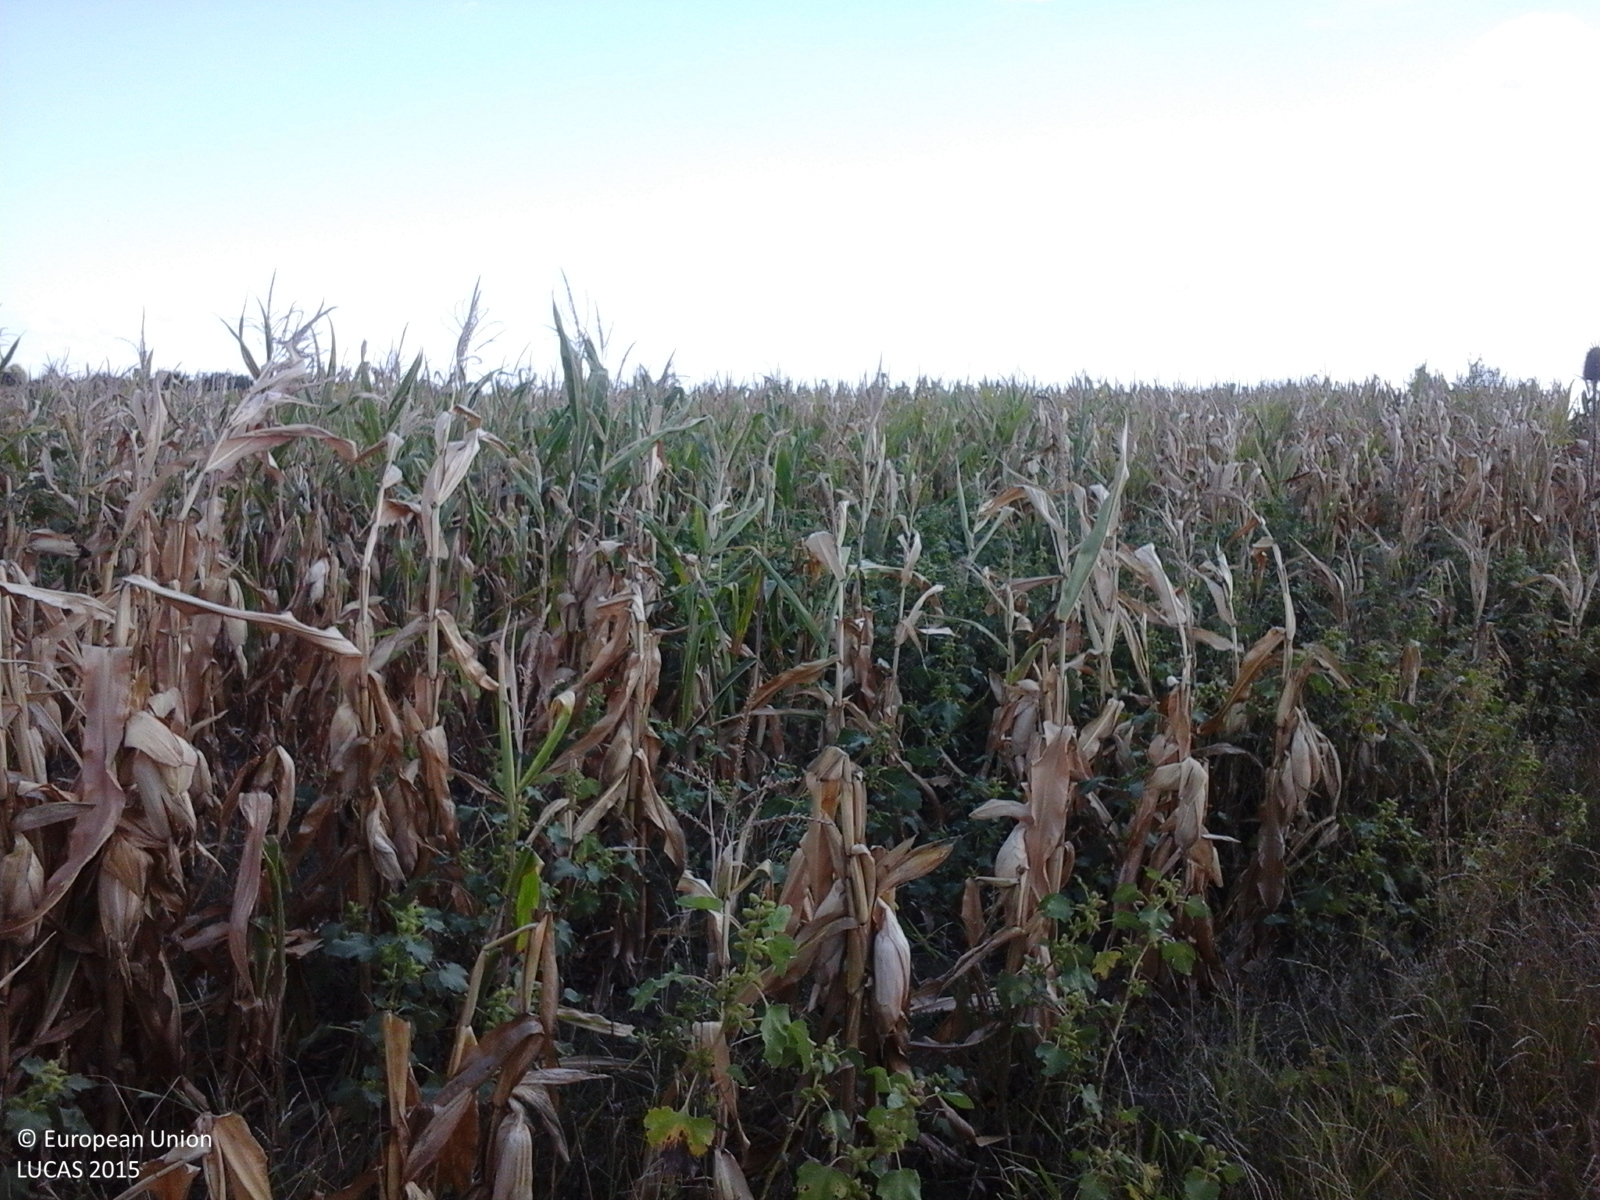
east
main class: Cropland
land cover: Maize
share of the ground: > 75 %
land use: Agriculture (excluding fallow land and kitchen gardens)
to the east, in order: Maize; Shrubland with sparse tree cover; Maize; Grass margins; Tracks; Grass margins; Shrubland with sparse tree cover; Rivers and streams; Shrubland with sparse tree cover
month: September
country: RO
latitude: 47.5823
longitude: 22.6511
